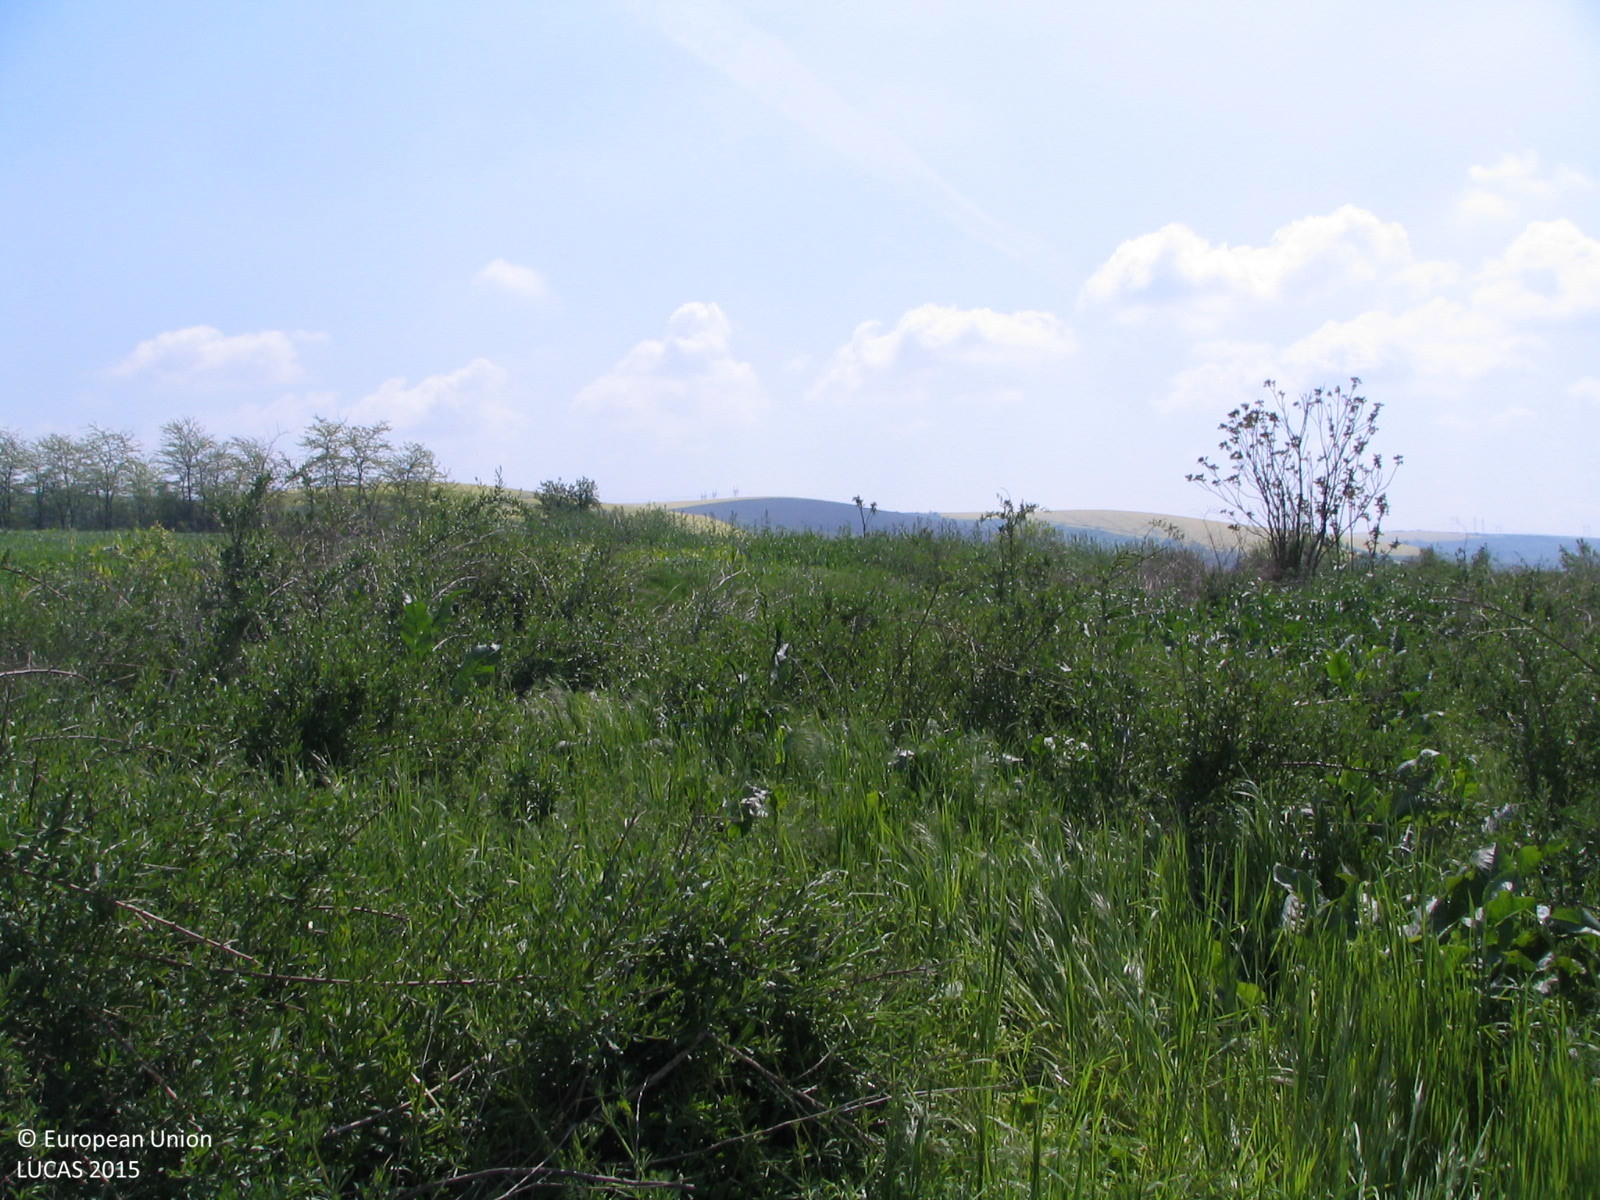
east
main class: Shrubland
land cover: Shrubland without tree cover
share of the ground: > 75 %
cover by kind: shrubs 60 %, herbaceous plants 40 %
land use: Fallow land
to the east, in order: Shrubland without tree cover; Tracks; Grass margins; Common wheat; Maize; Broadleaved woodland; Ditches and canals; Paved roads, cycling and walking lanes; Ditches and canals; Broadleaved woodland; Shrubland with sparse tree cover; Spontaneously vegetated surfaces; Common wheat
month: May
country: BG
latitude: 43.6717
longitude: 23.8562
